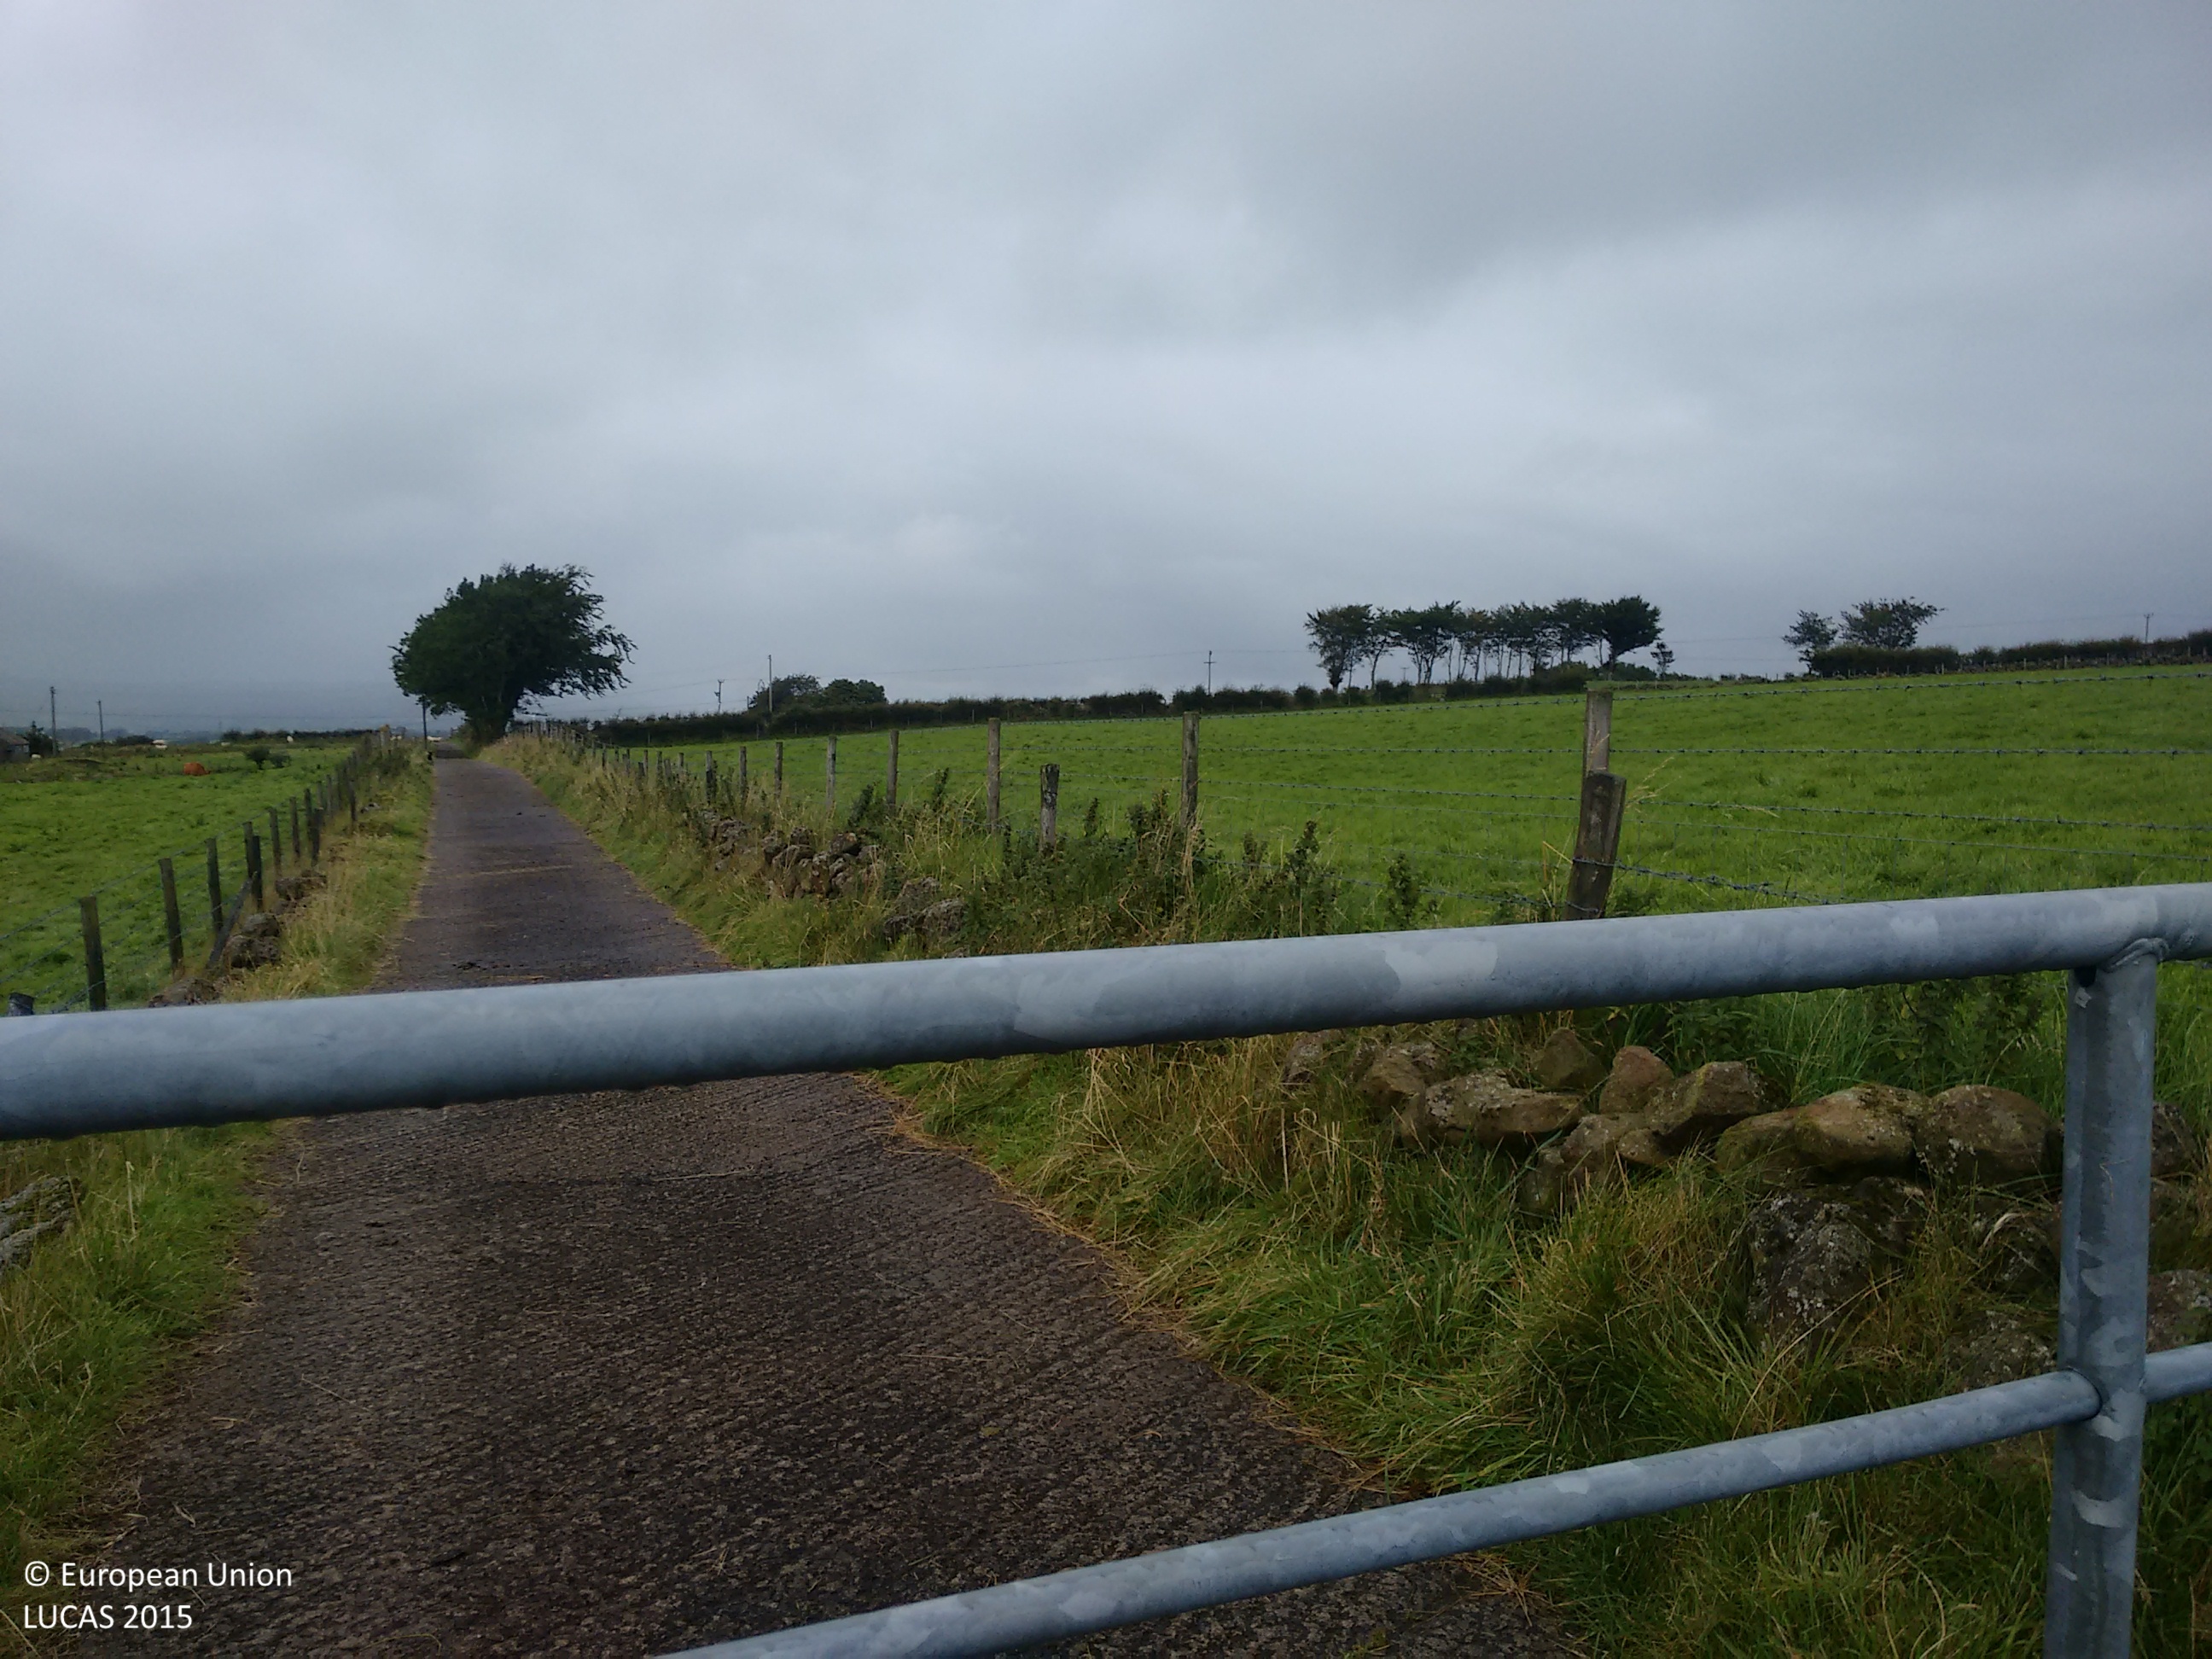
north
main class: Grassland
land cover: Grassland without tree/shrub cover
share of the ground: > 75 %
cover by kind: herbaceous plants 100 %
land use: Agriculture (excluding fallow land and kitchen gardens)
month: September
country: GB
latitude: 54.7707
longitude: -5.8514
